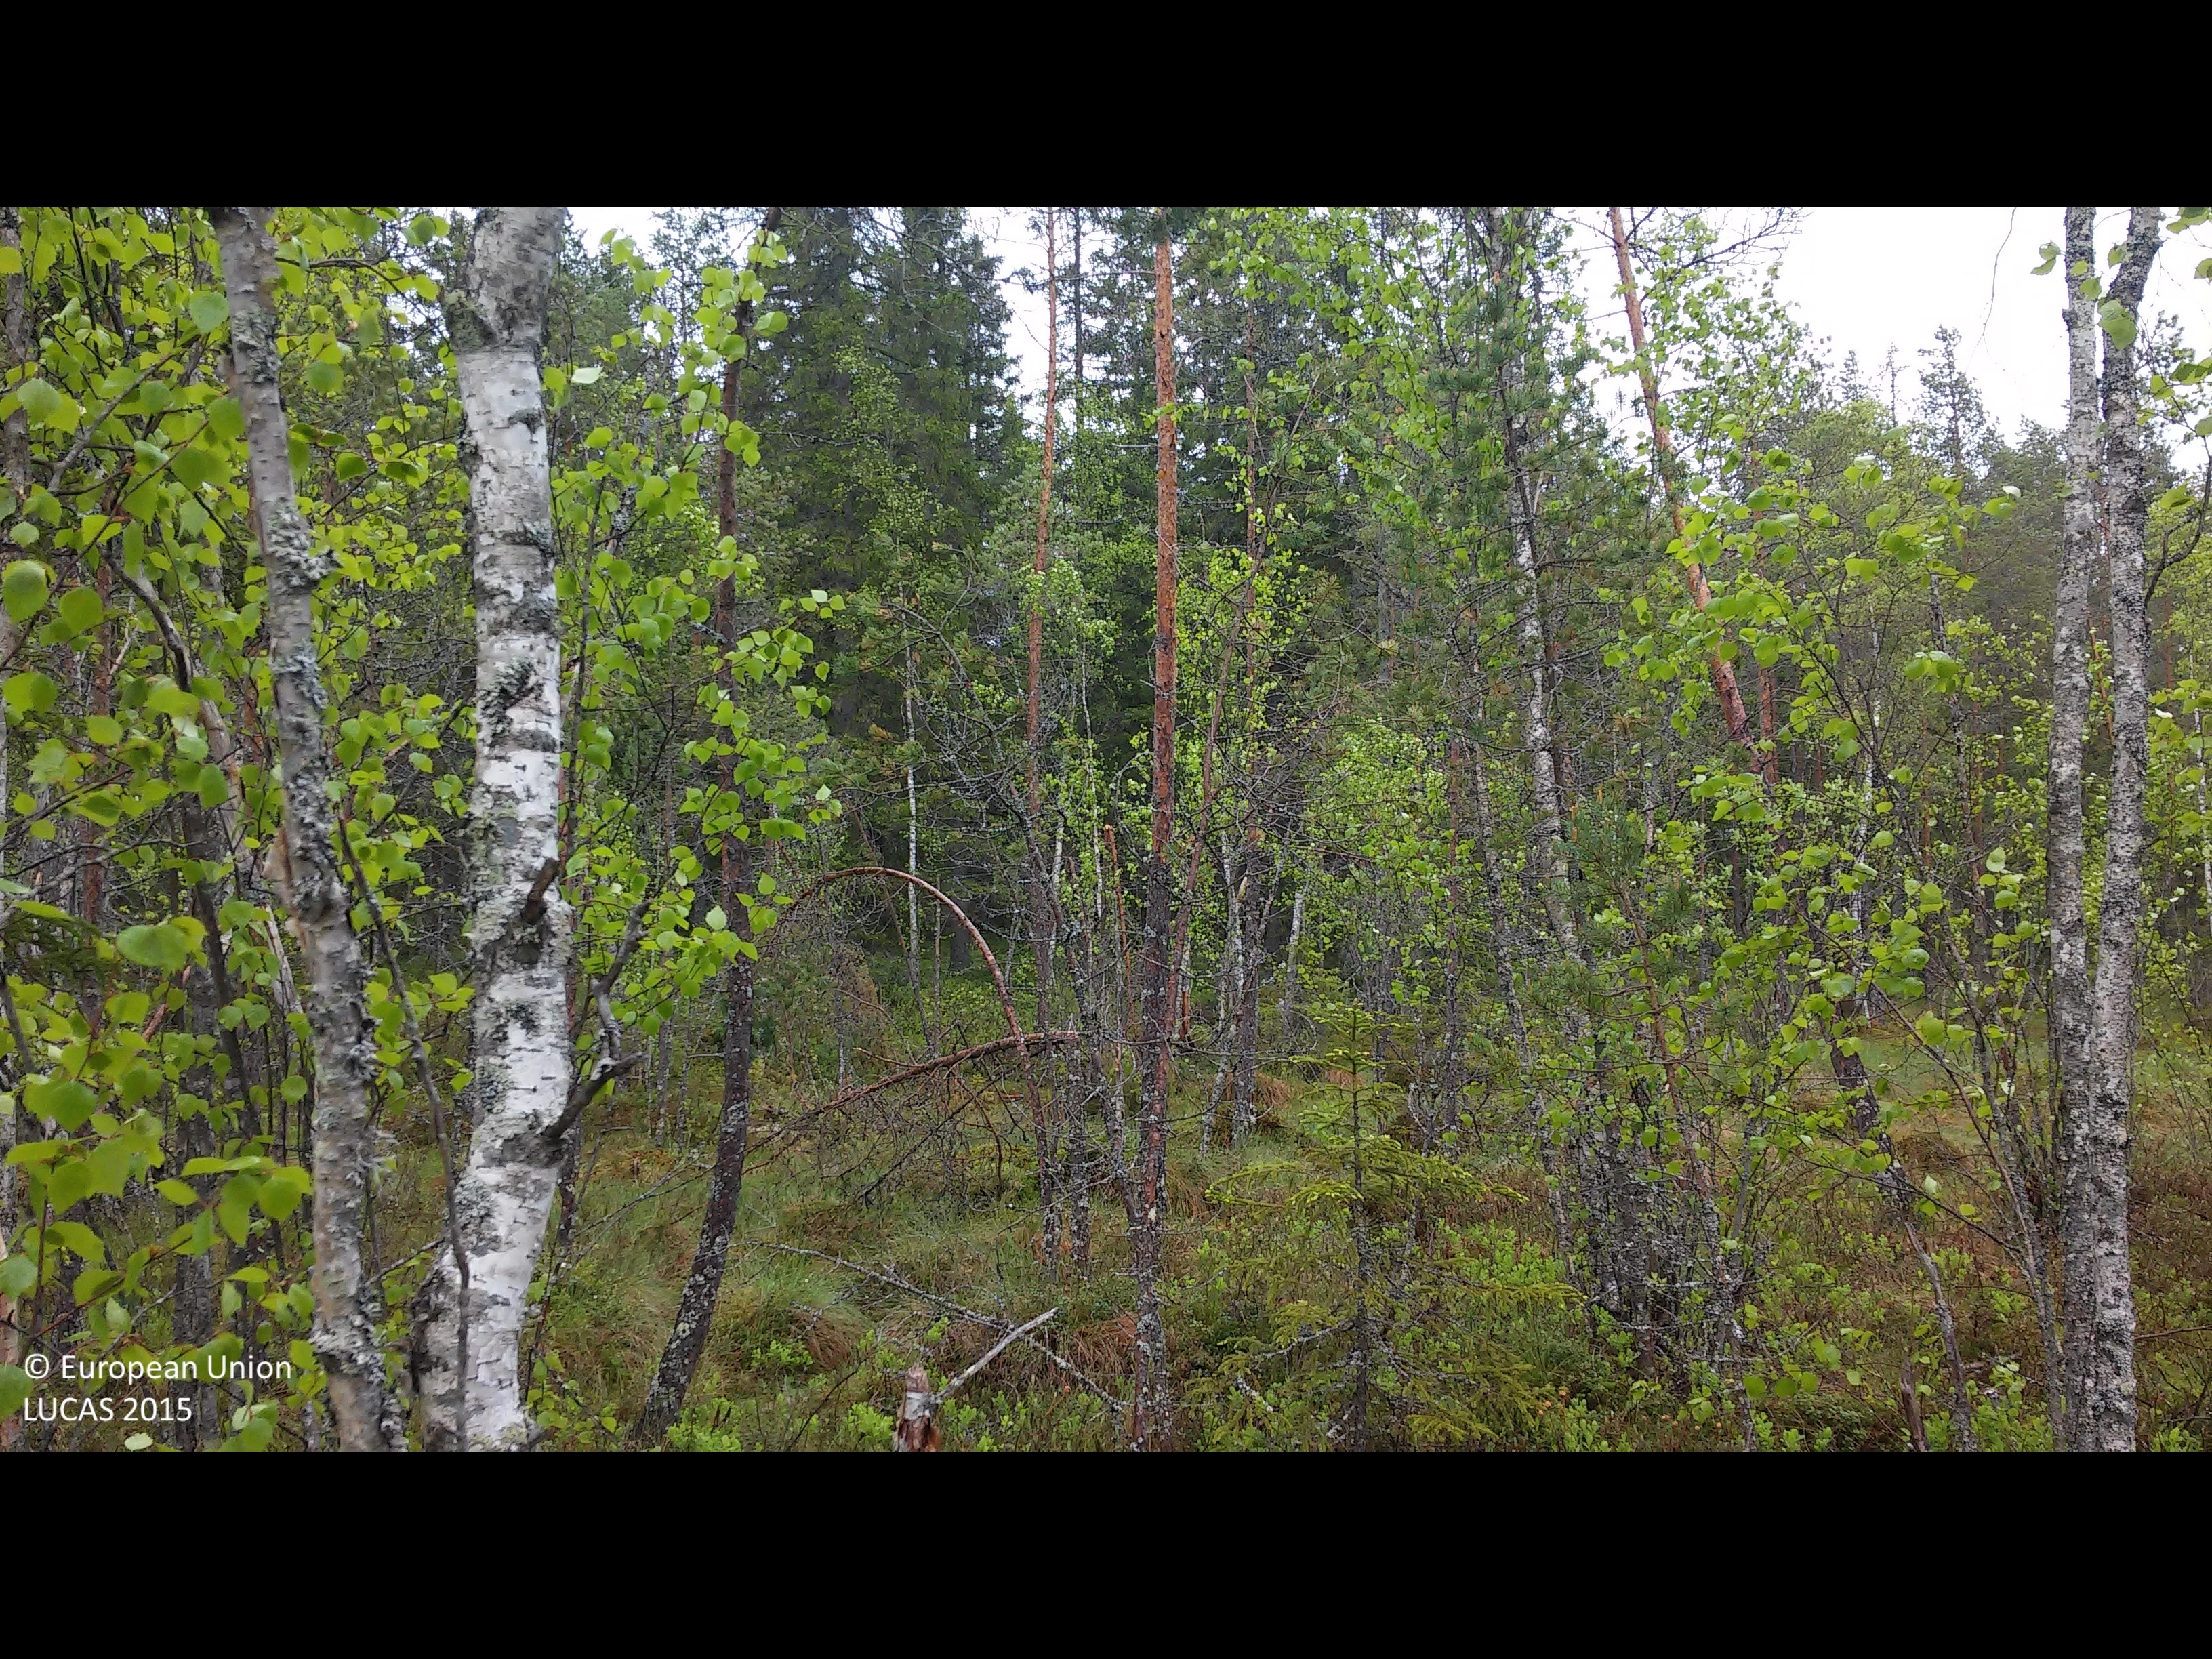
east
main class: Woodland
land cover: Pine dominated mixed woodland
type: boreal forest
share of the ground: > 75 %
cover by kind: coniferous forest trees 55 %, broadleaved forest trees 20 %, shrubs 15 %, lichens and mosses 10 %
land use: Semi-natural and natural areas not in use
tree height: > 5 m
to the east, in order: Pine dominated mixed woodland; Other mixed woodland; Ditches and canals; Spruce dominated coniferous woodland; Other mixed woodland
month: June
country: FI
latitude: 63.7030
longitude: 23.9669
